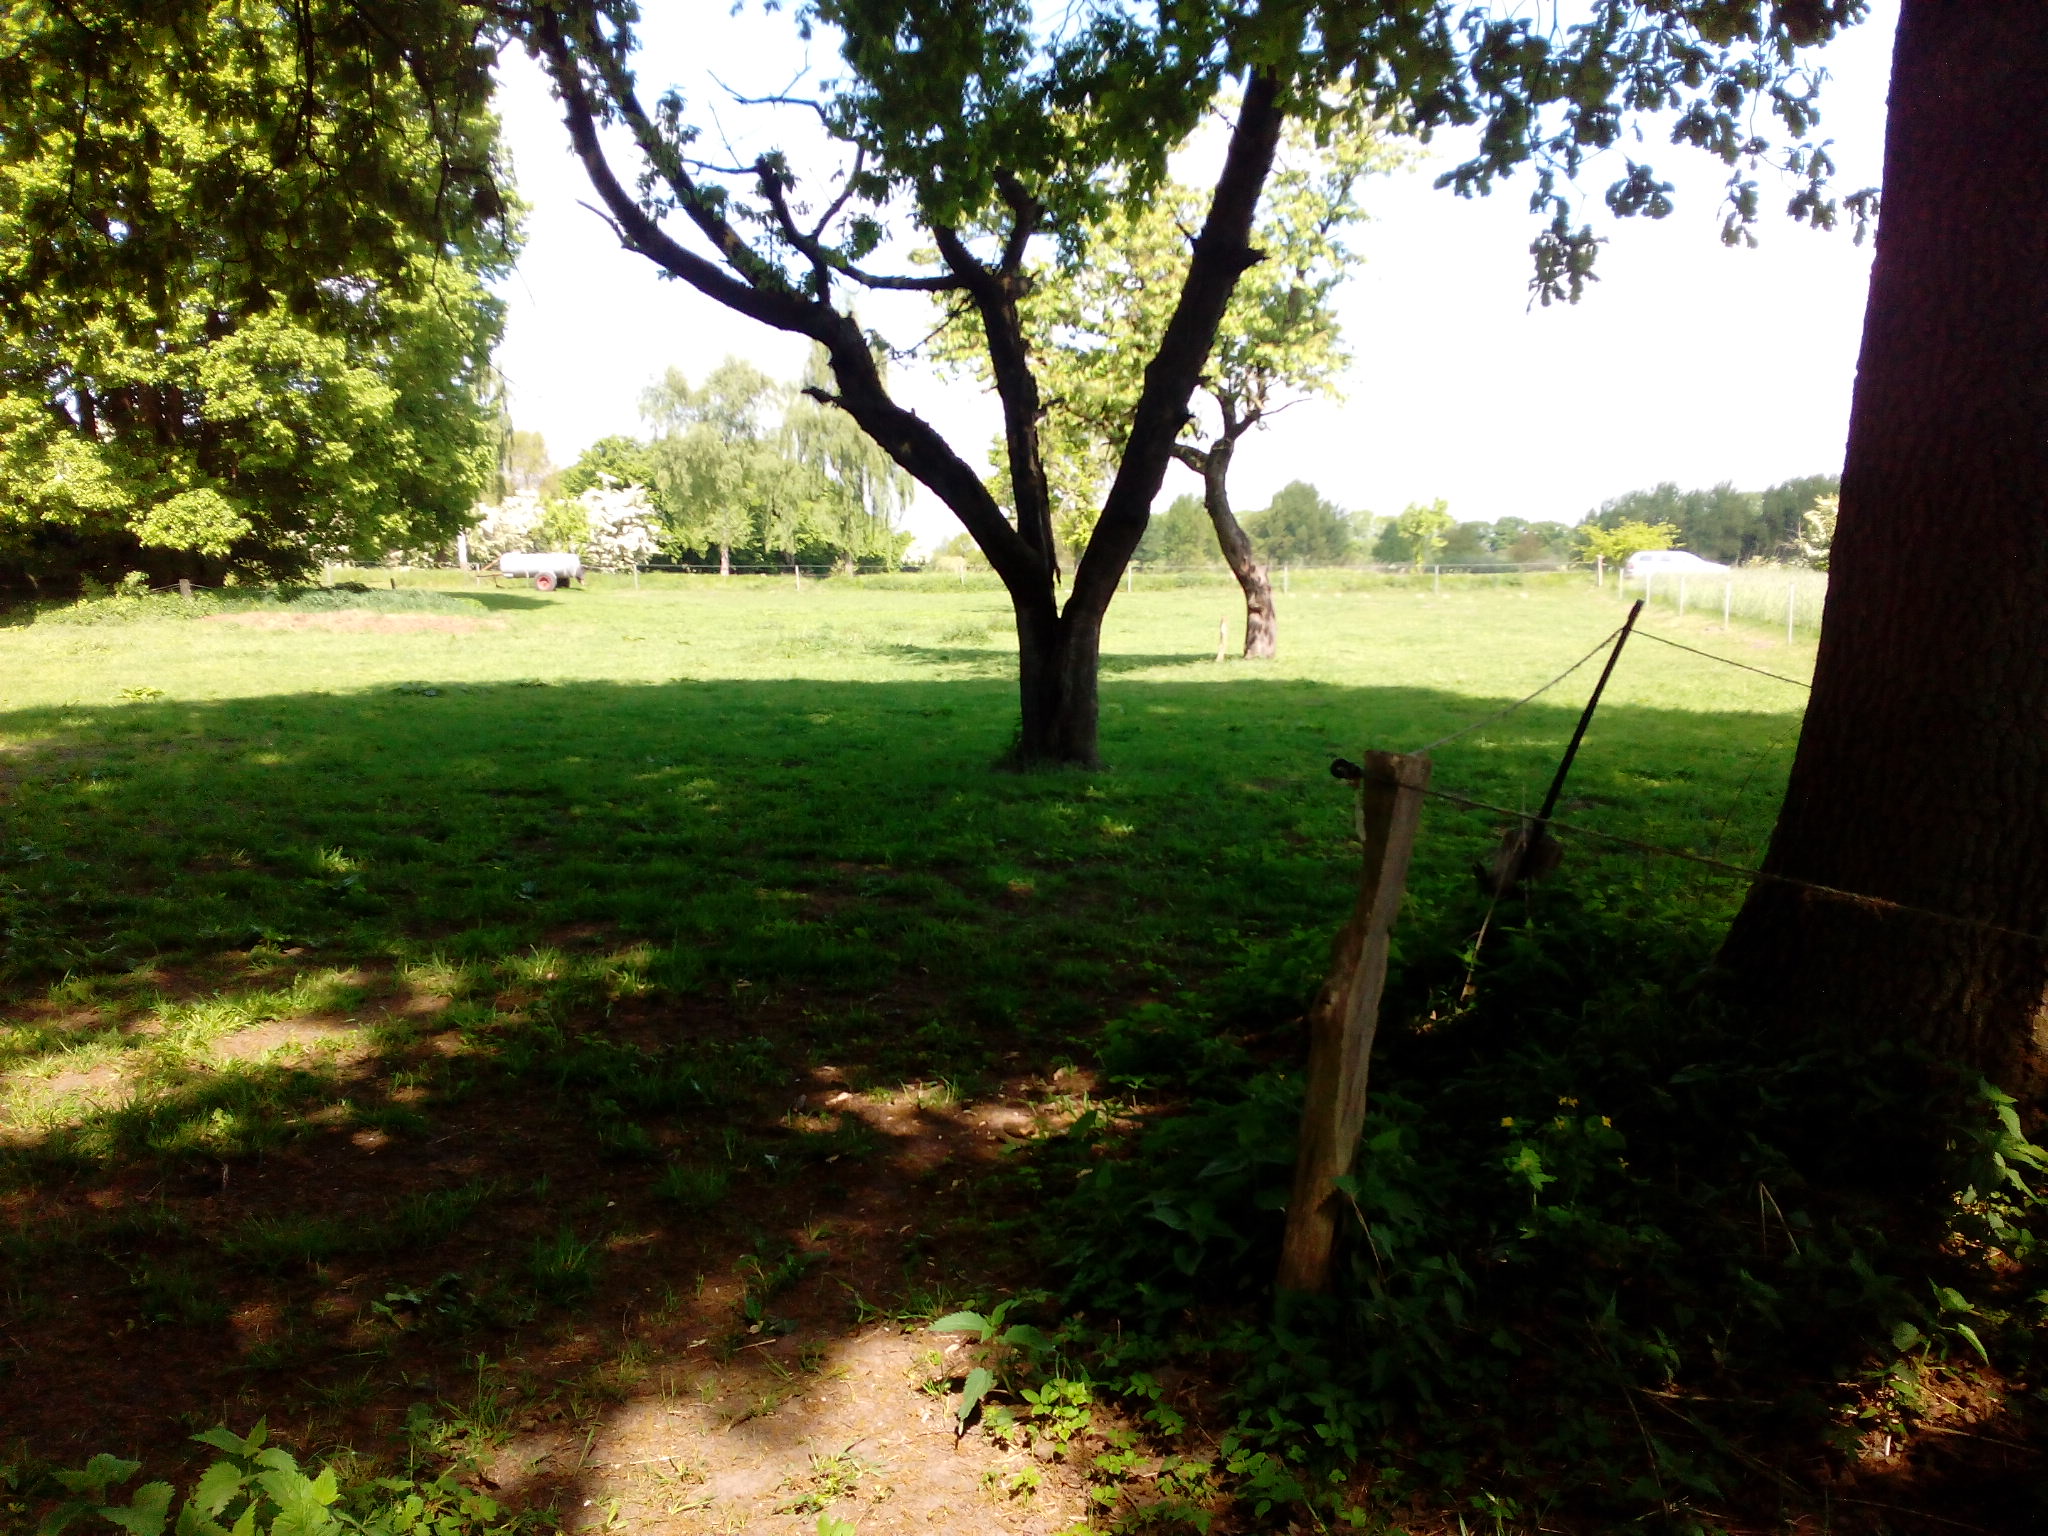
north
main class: Woodland
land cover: Broadleaved woodland
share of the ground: 25 - 50 %
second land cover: Grassland without tree/shrub cover
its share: > 75 %
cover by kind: broadleaved forest trees 60 %, herbaceous plants 40 %
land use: Forestry
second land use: Agriculture (excluding fallow land and kitchen gardens)
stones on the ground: < 10 %
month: May
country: DE
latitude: 52.4668
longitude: 9.6321
